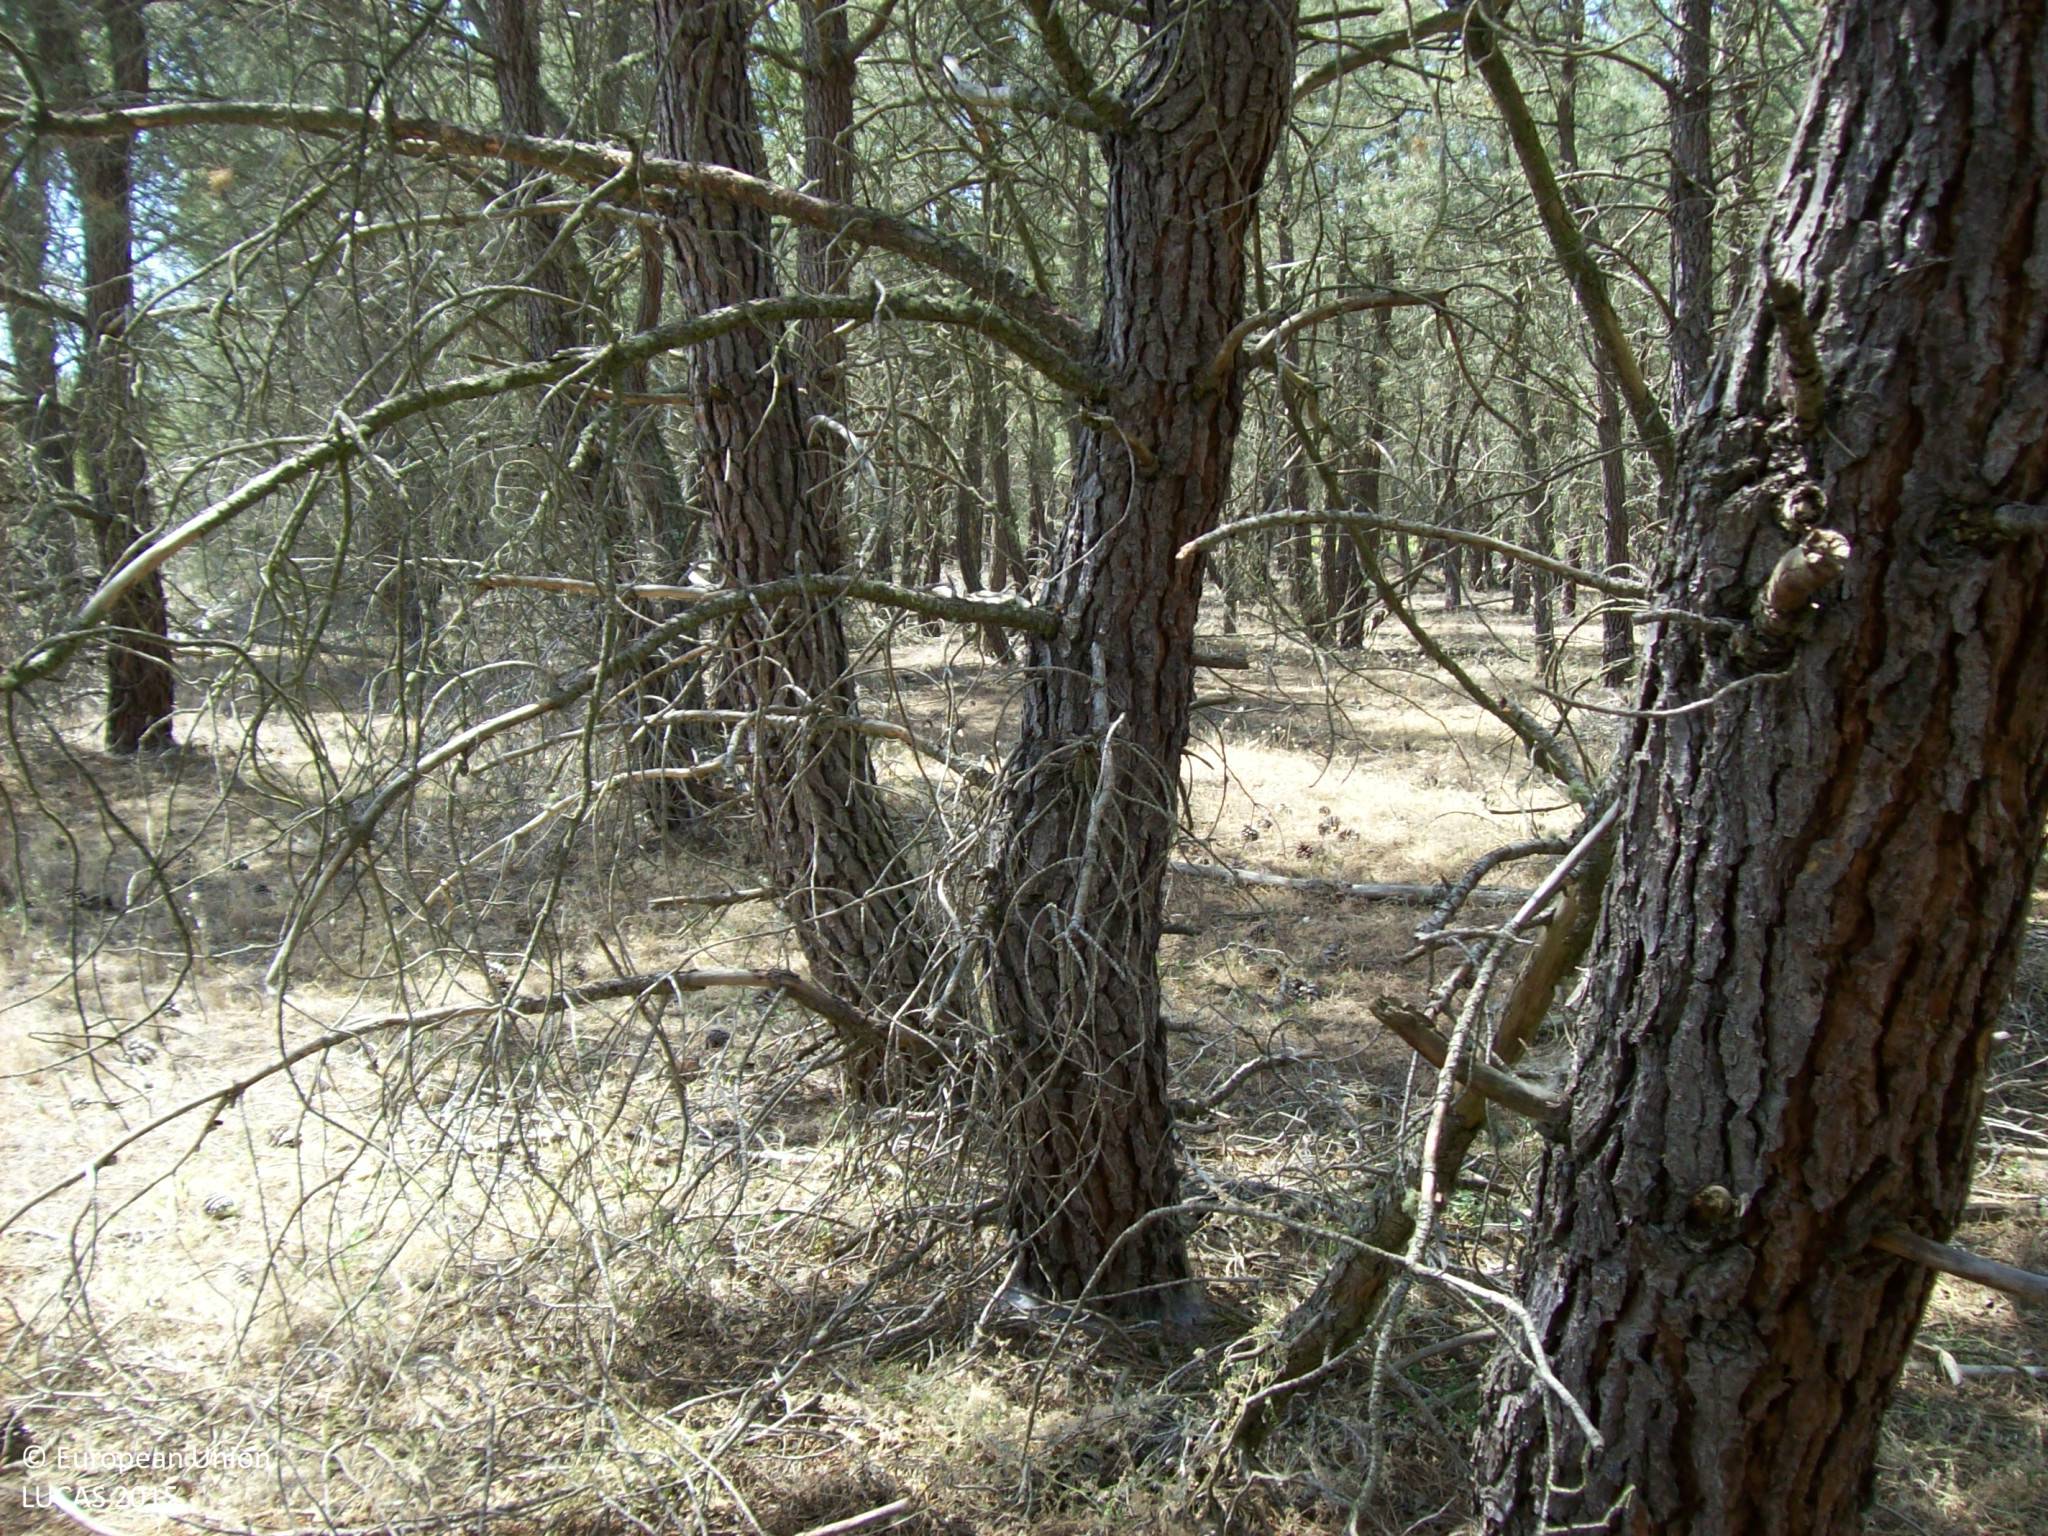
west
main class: Woodland
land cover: Pine dominated coniferous woodland
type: coniferous forest of the mediterranean region
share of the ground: 50 - 75 %
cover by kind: coniferous forest trees 60 %, unconsolidated bare surface 30 %, herbaceous plants 5 %, lichens and mosses 5 %
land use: Forestry
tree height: > 5 m
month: June
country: ES
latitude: 41.1588
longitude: -4.5389
